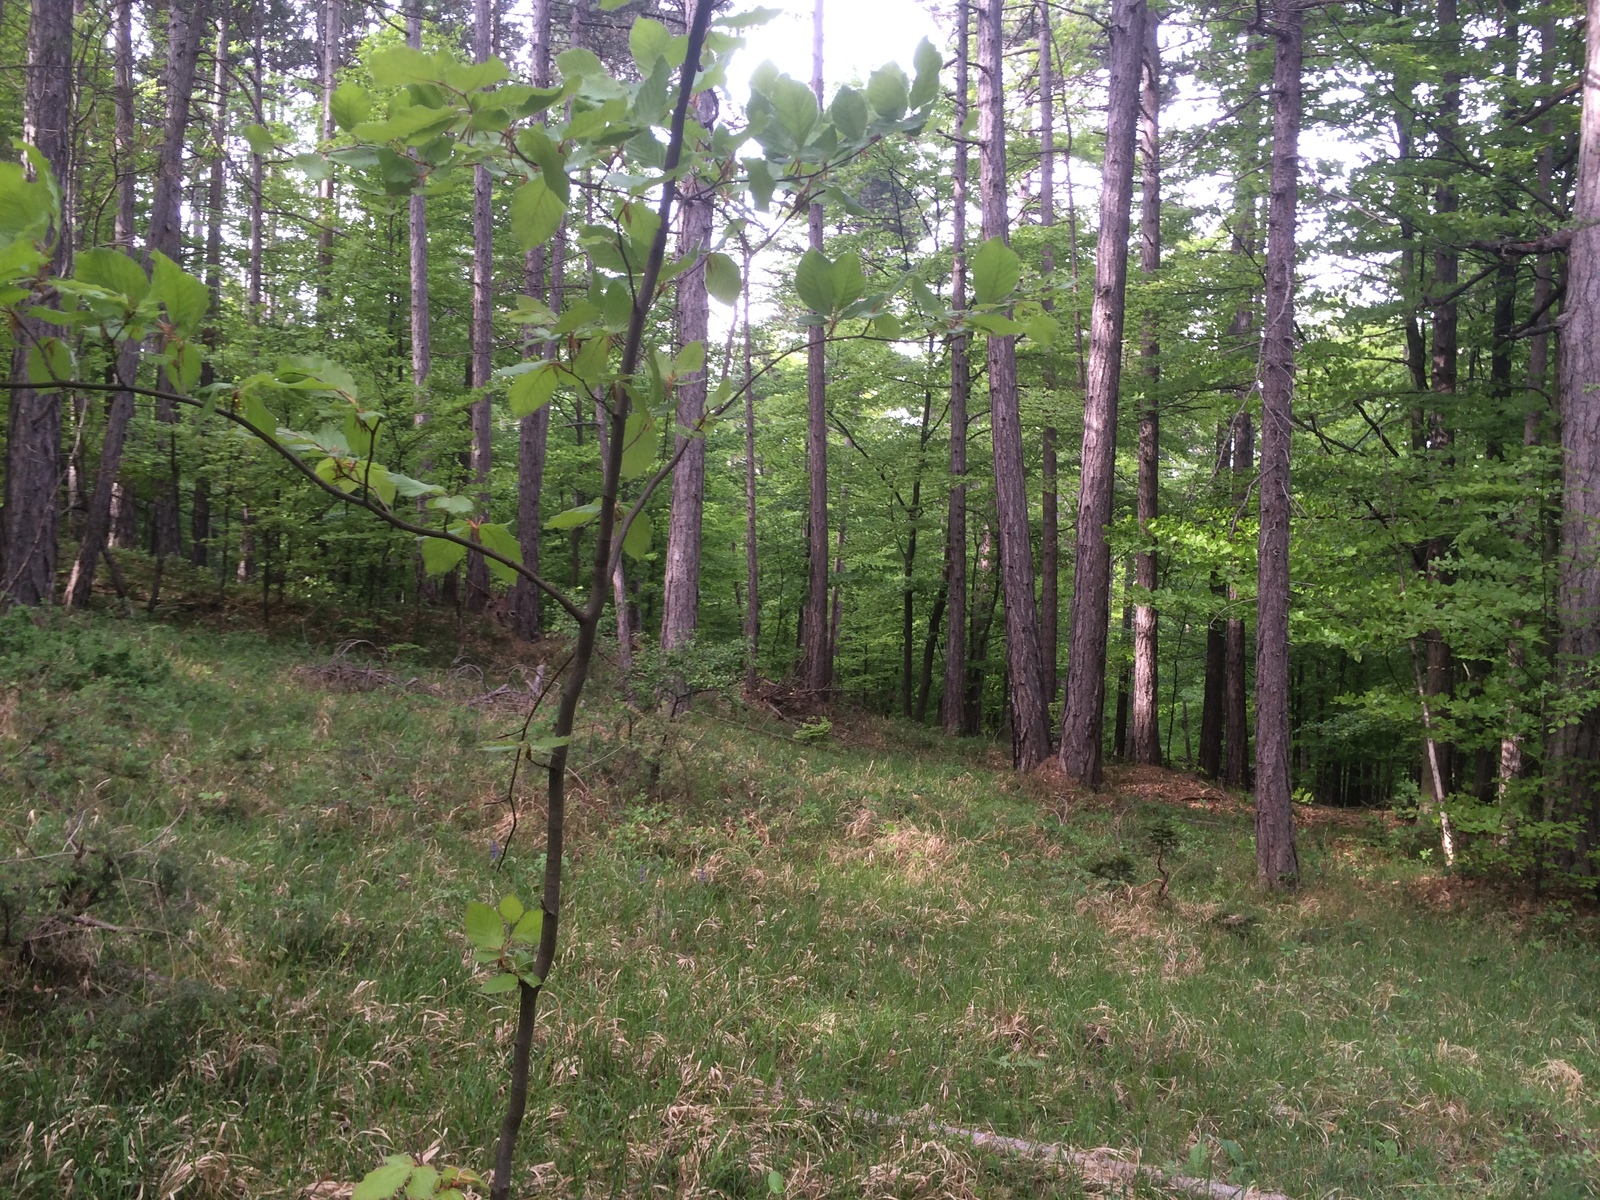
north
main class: Woodland
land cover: Pine dominated coniferous woodland
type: alpine coniferous forest
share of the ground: > 75 %
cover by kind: coniferous forest trees 95 %, broadleaved forest trees 5 %
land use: Forestry
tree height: > 5 m
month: May
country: AT
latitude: 47.9108
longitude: 16.0911
